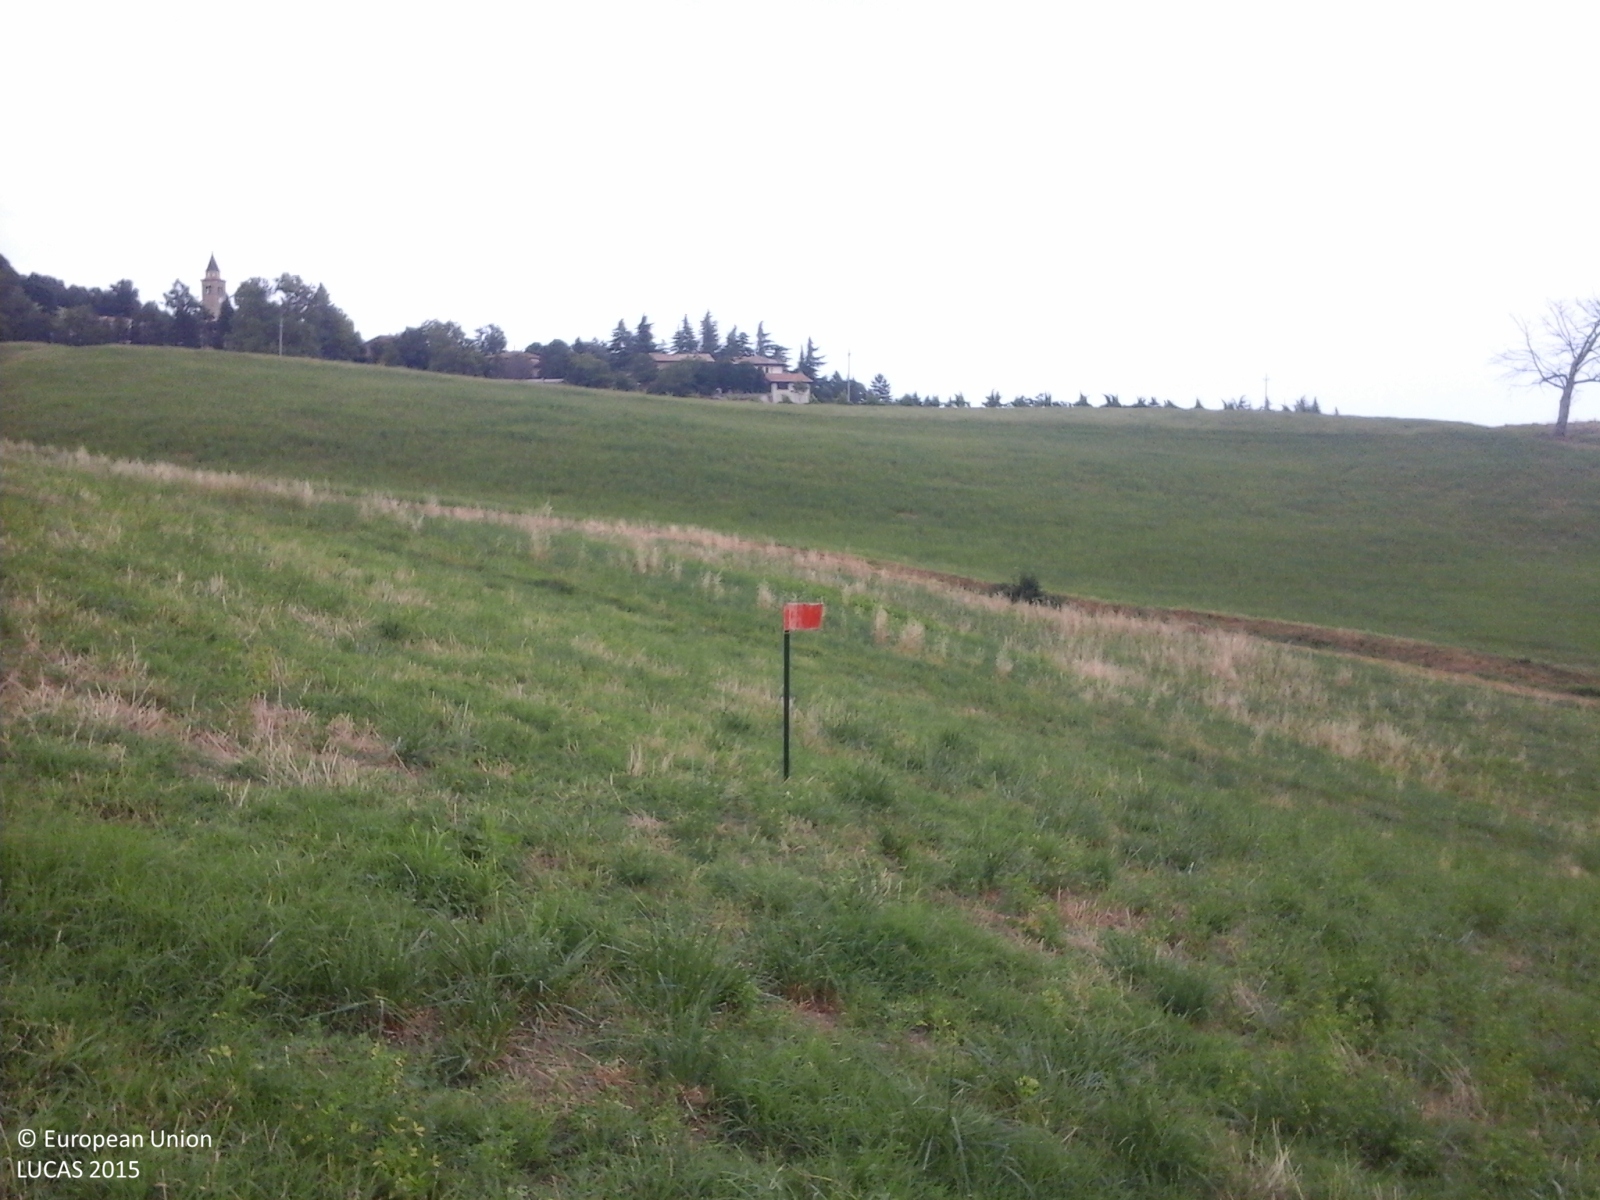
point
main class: Grassland
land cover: Grassland without tree/shrub cover
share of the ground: > 75 %
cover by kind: herbaceous plants 100 %
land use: Agriculture (excluding fallow land and kitchen gardens)
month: June
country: IT
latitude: 44.5666
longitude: 10.2890
